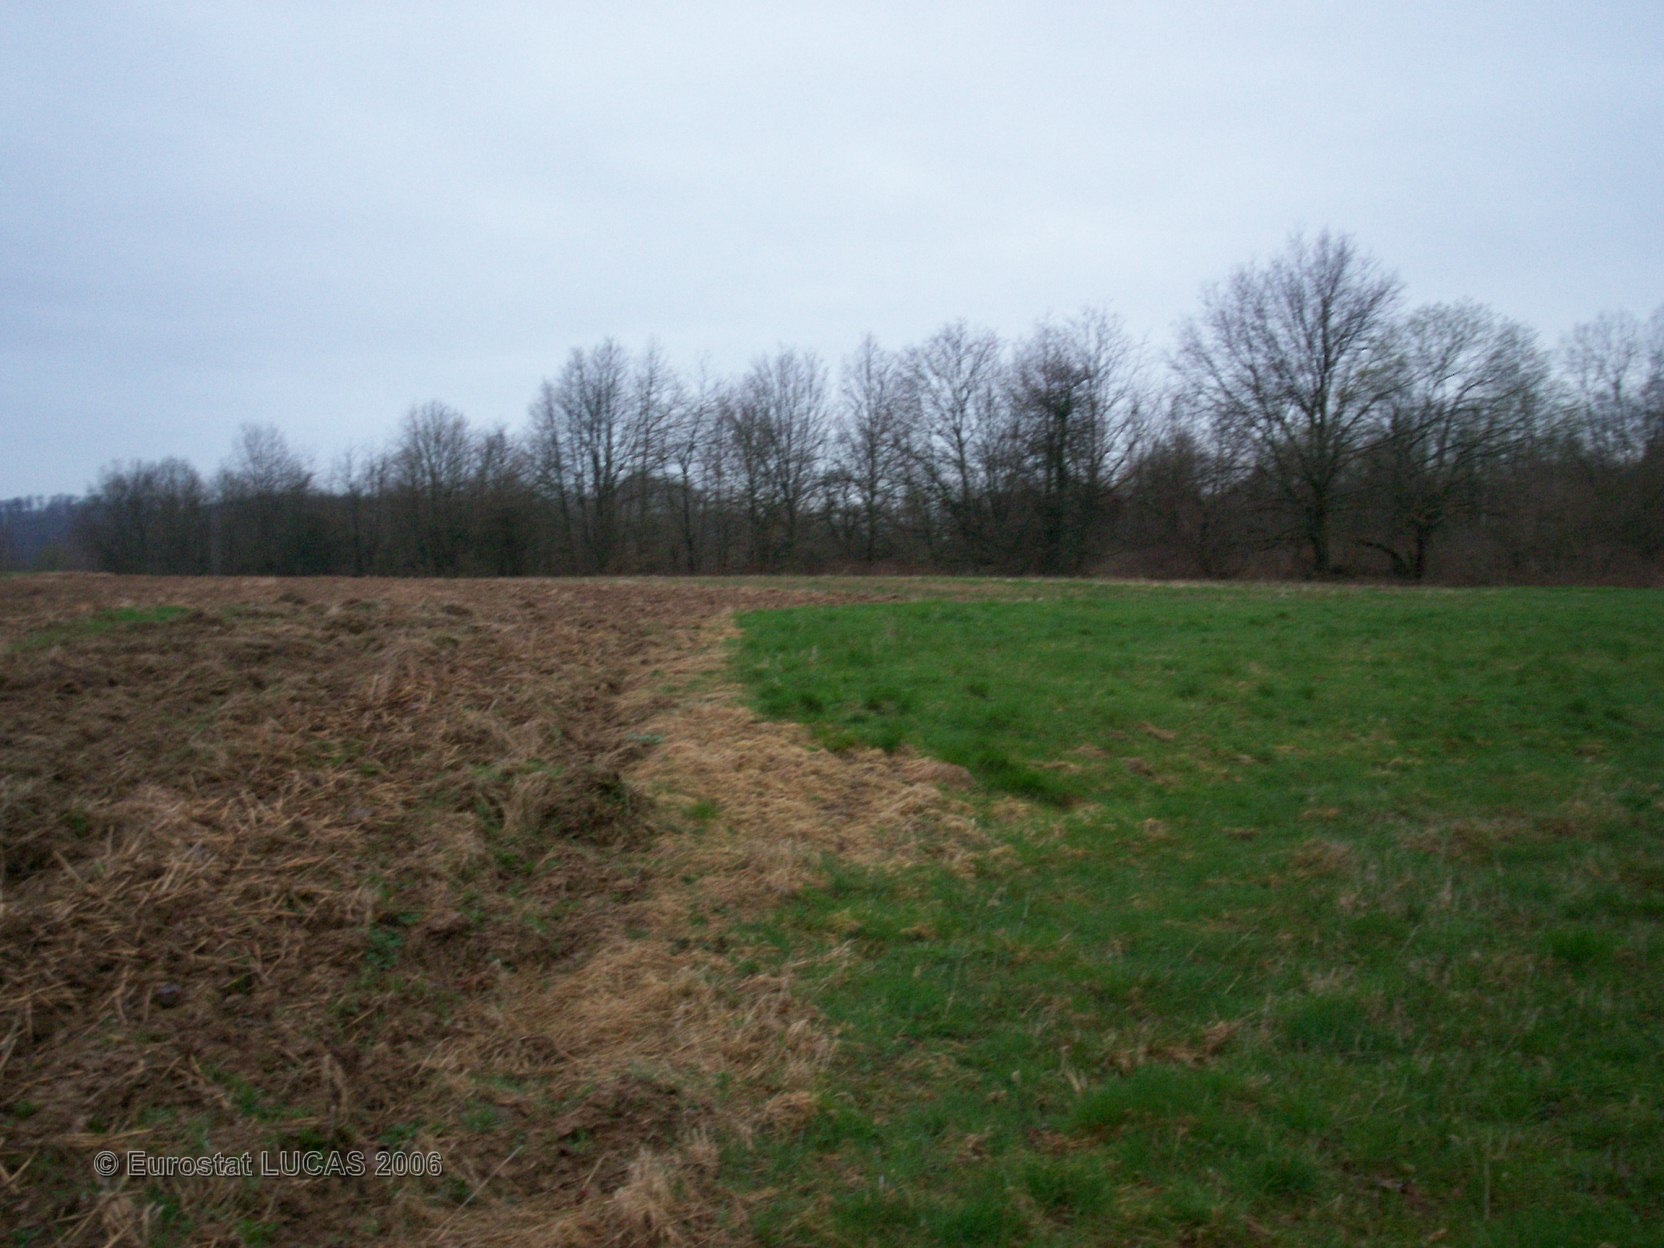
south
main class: Grassland
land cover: Grassland without tree/shrub cover
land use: Agriculture (excluding fallow land and kitchen gardens)
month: April
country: FR
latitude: 47.6122
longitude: 6.5825
